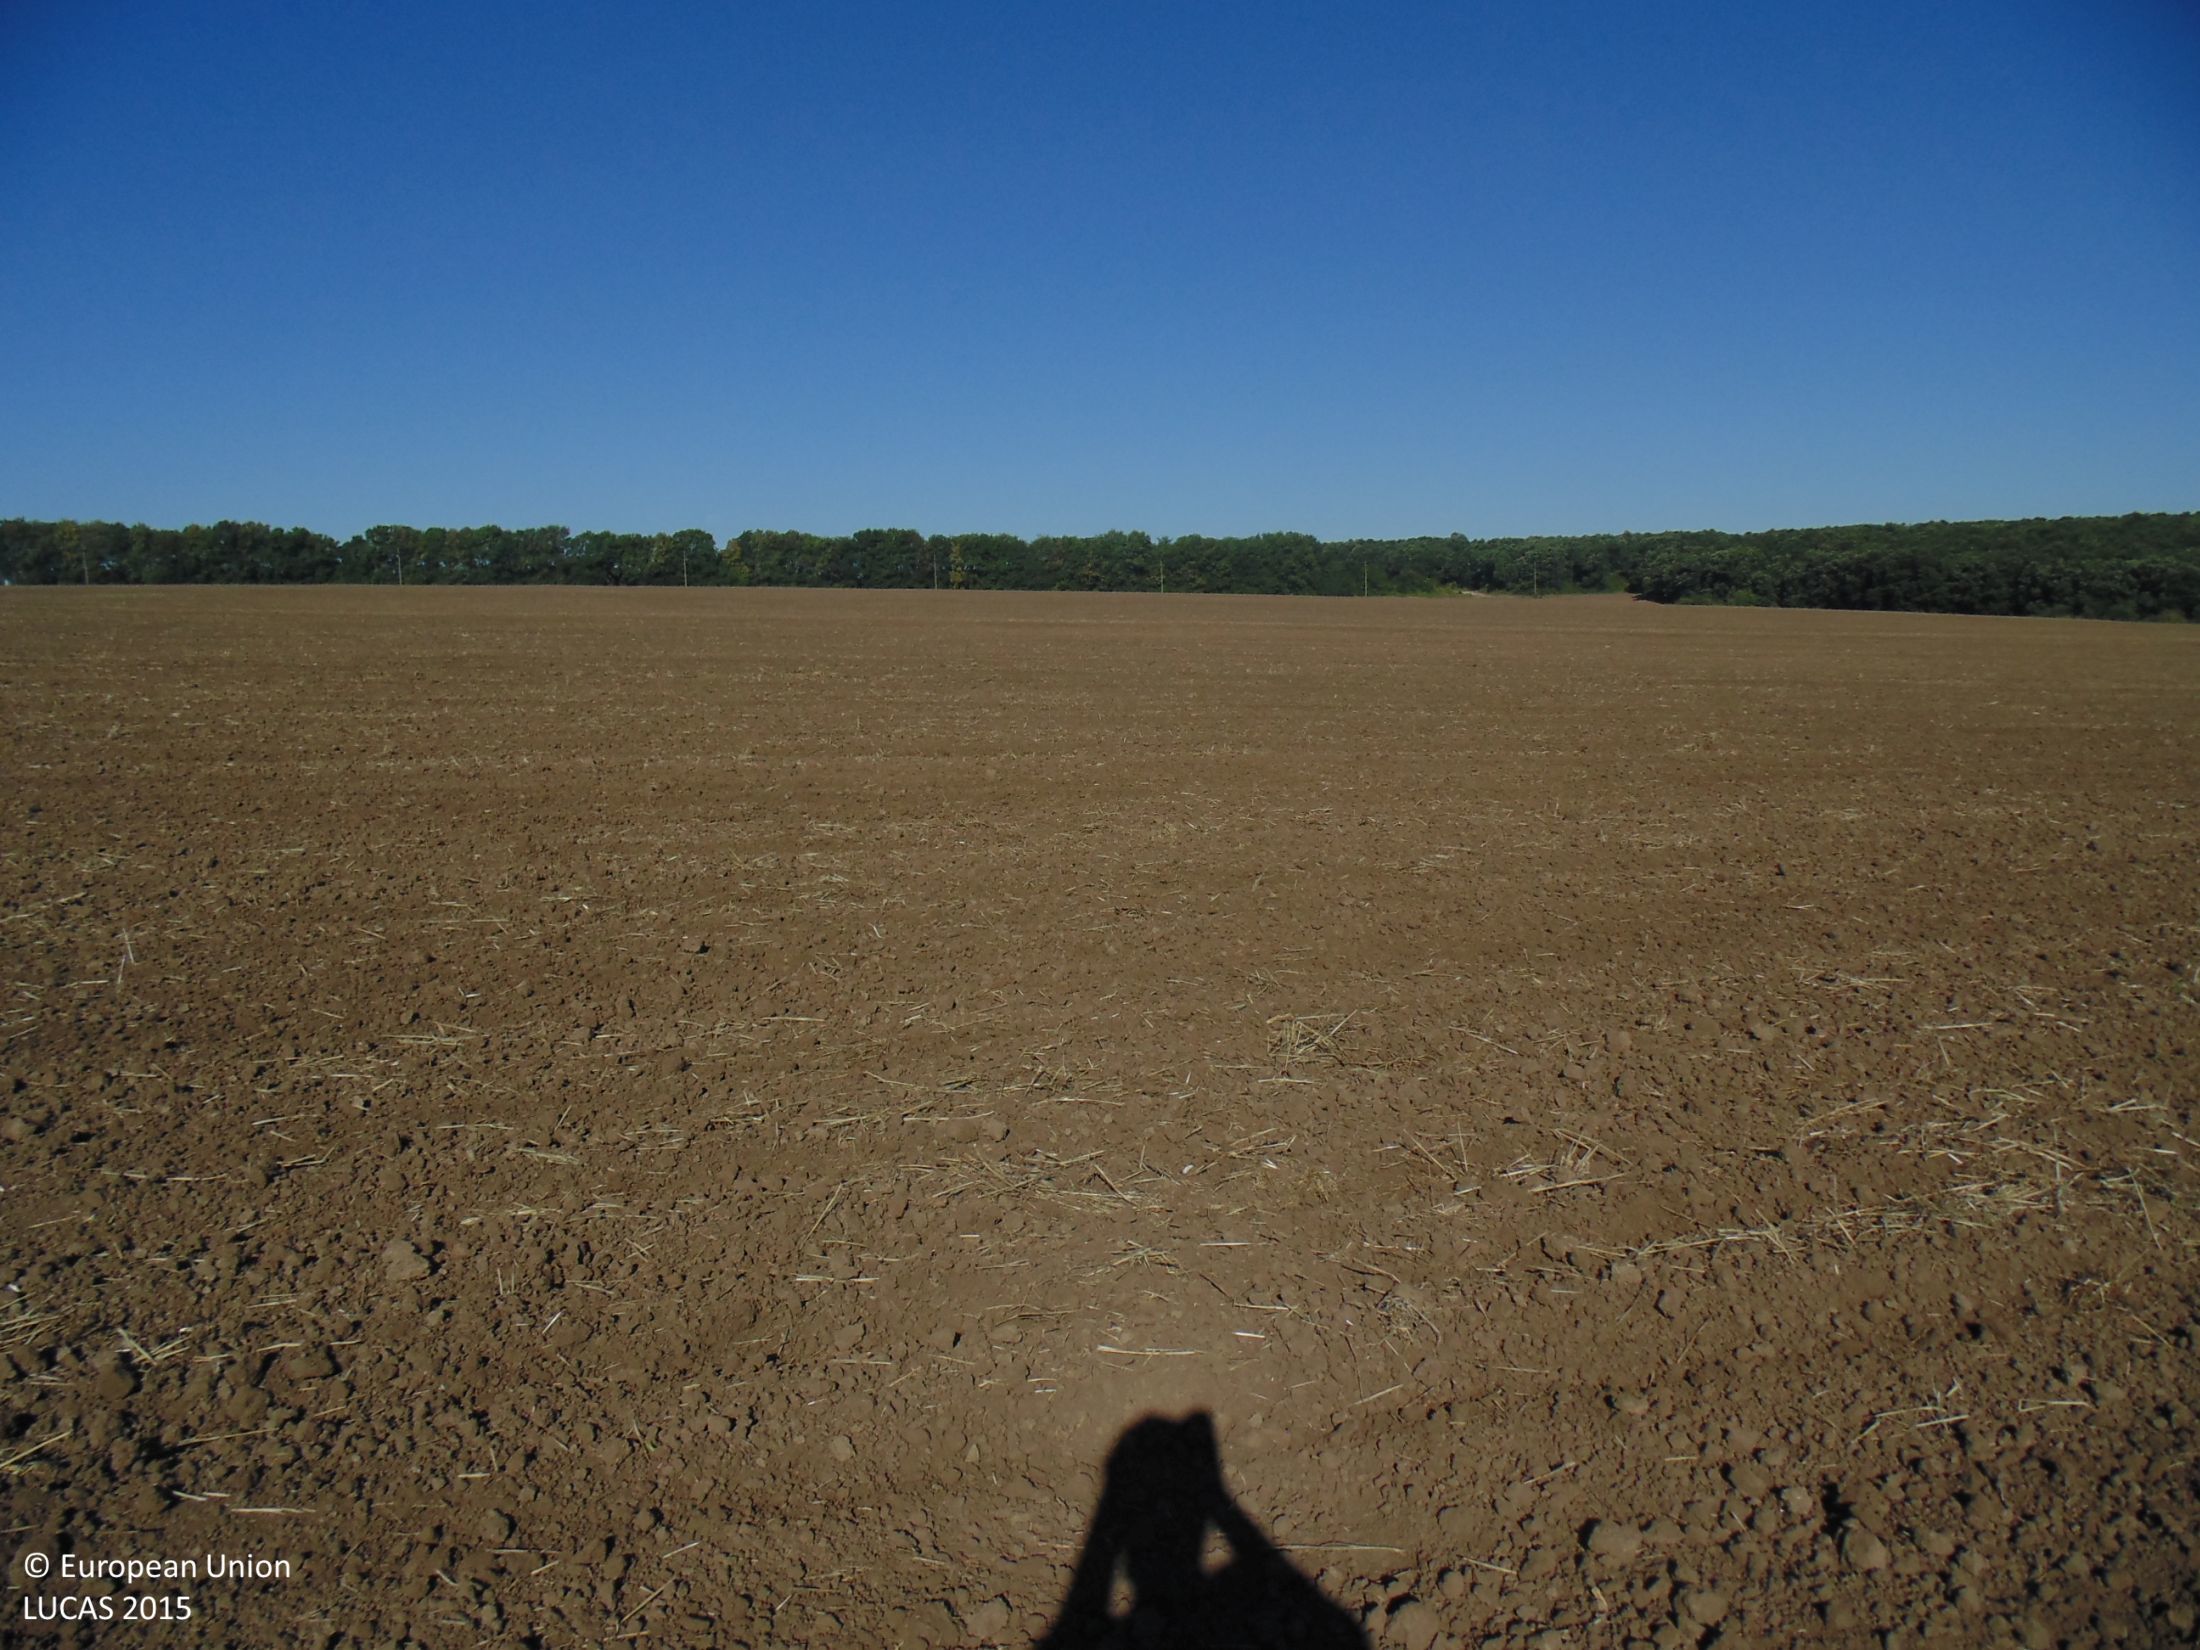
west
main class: Cropland
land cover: Common wheat
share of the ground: < 10 %
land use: Agriculture (excluding fallow land and kitchen gardens)
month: September
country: BG
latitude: 43.7663
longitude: 27.3089
